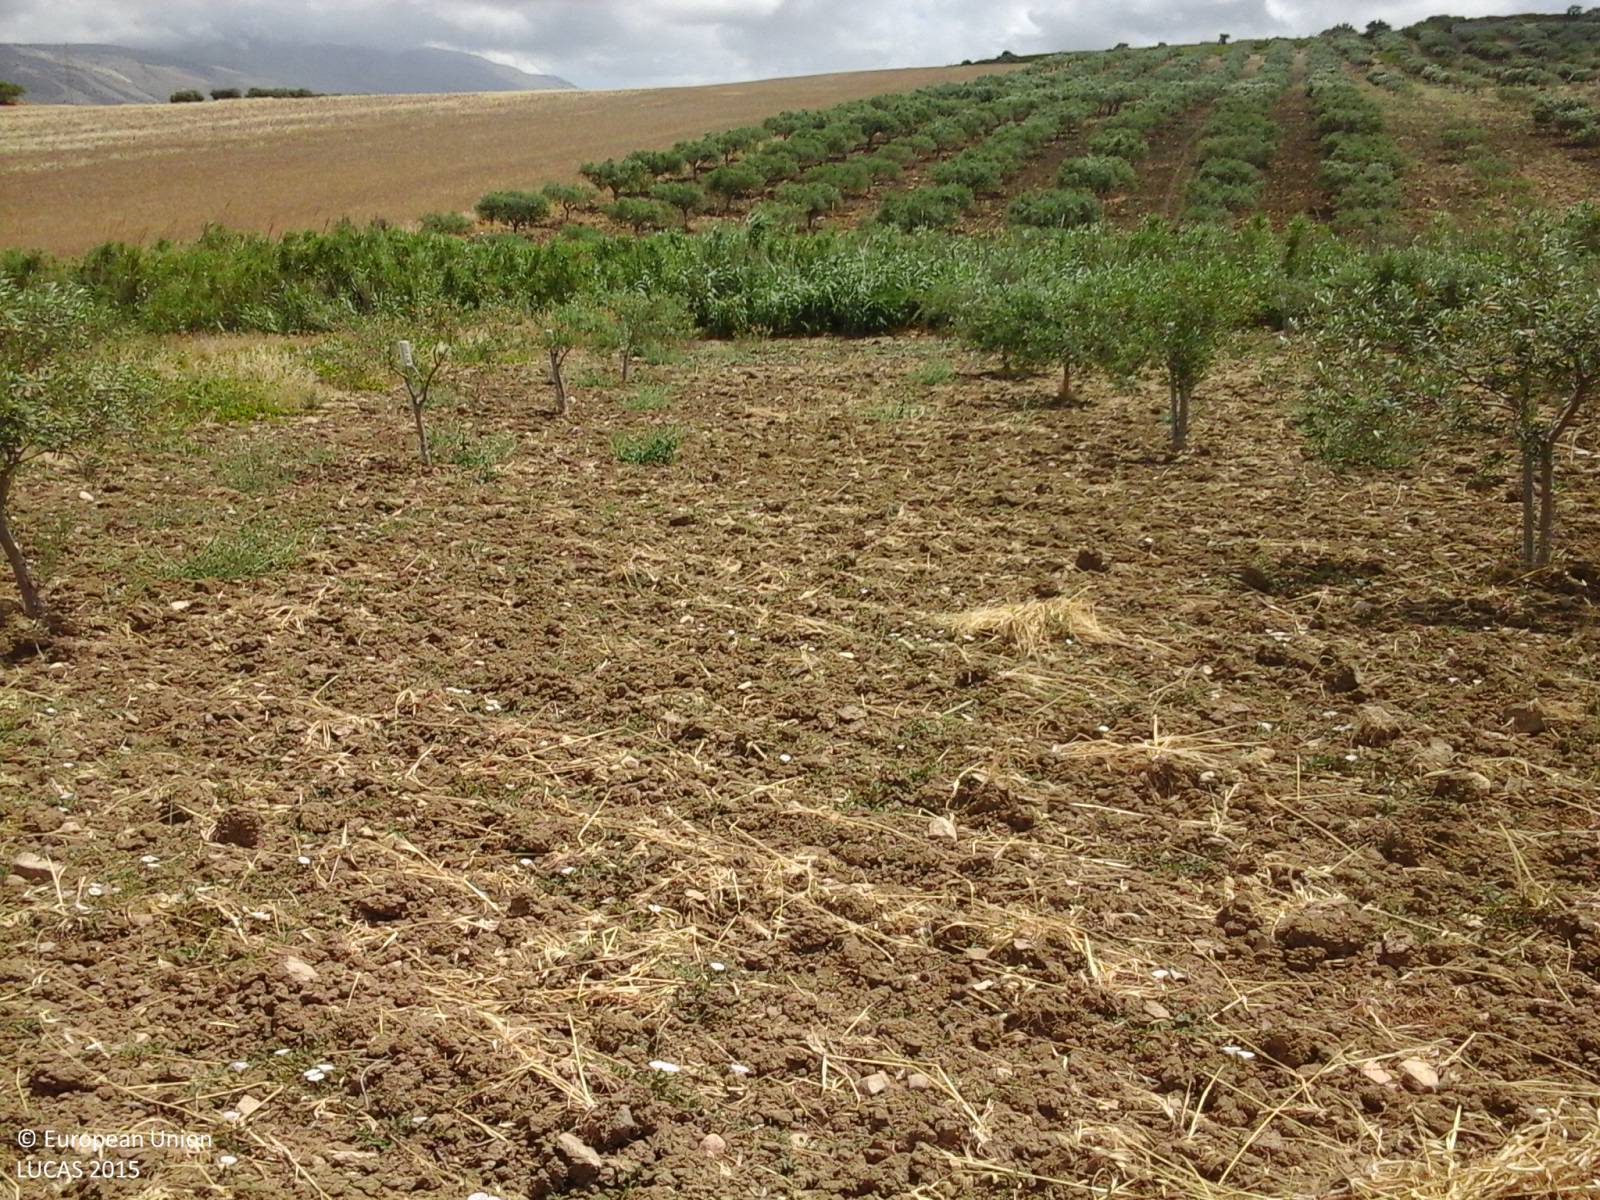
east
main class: Cropland
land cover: Olive groves
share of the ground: 25 - 50 %
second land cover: Other bare soil
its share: > 75 %
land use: Agriculture (excluding fallow land and kitchen gardens)
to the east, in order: Olive groves; Other bare soil; Shrubland without tree cover; Rivers and streams; Shrubland without tree cover; Olive groves; Durum wheat
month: June
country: IT
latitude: 38.0367
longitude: 12.6810
